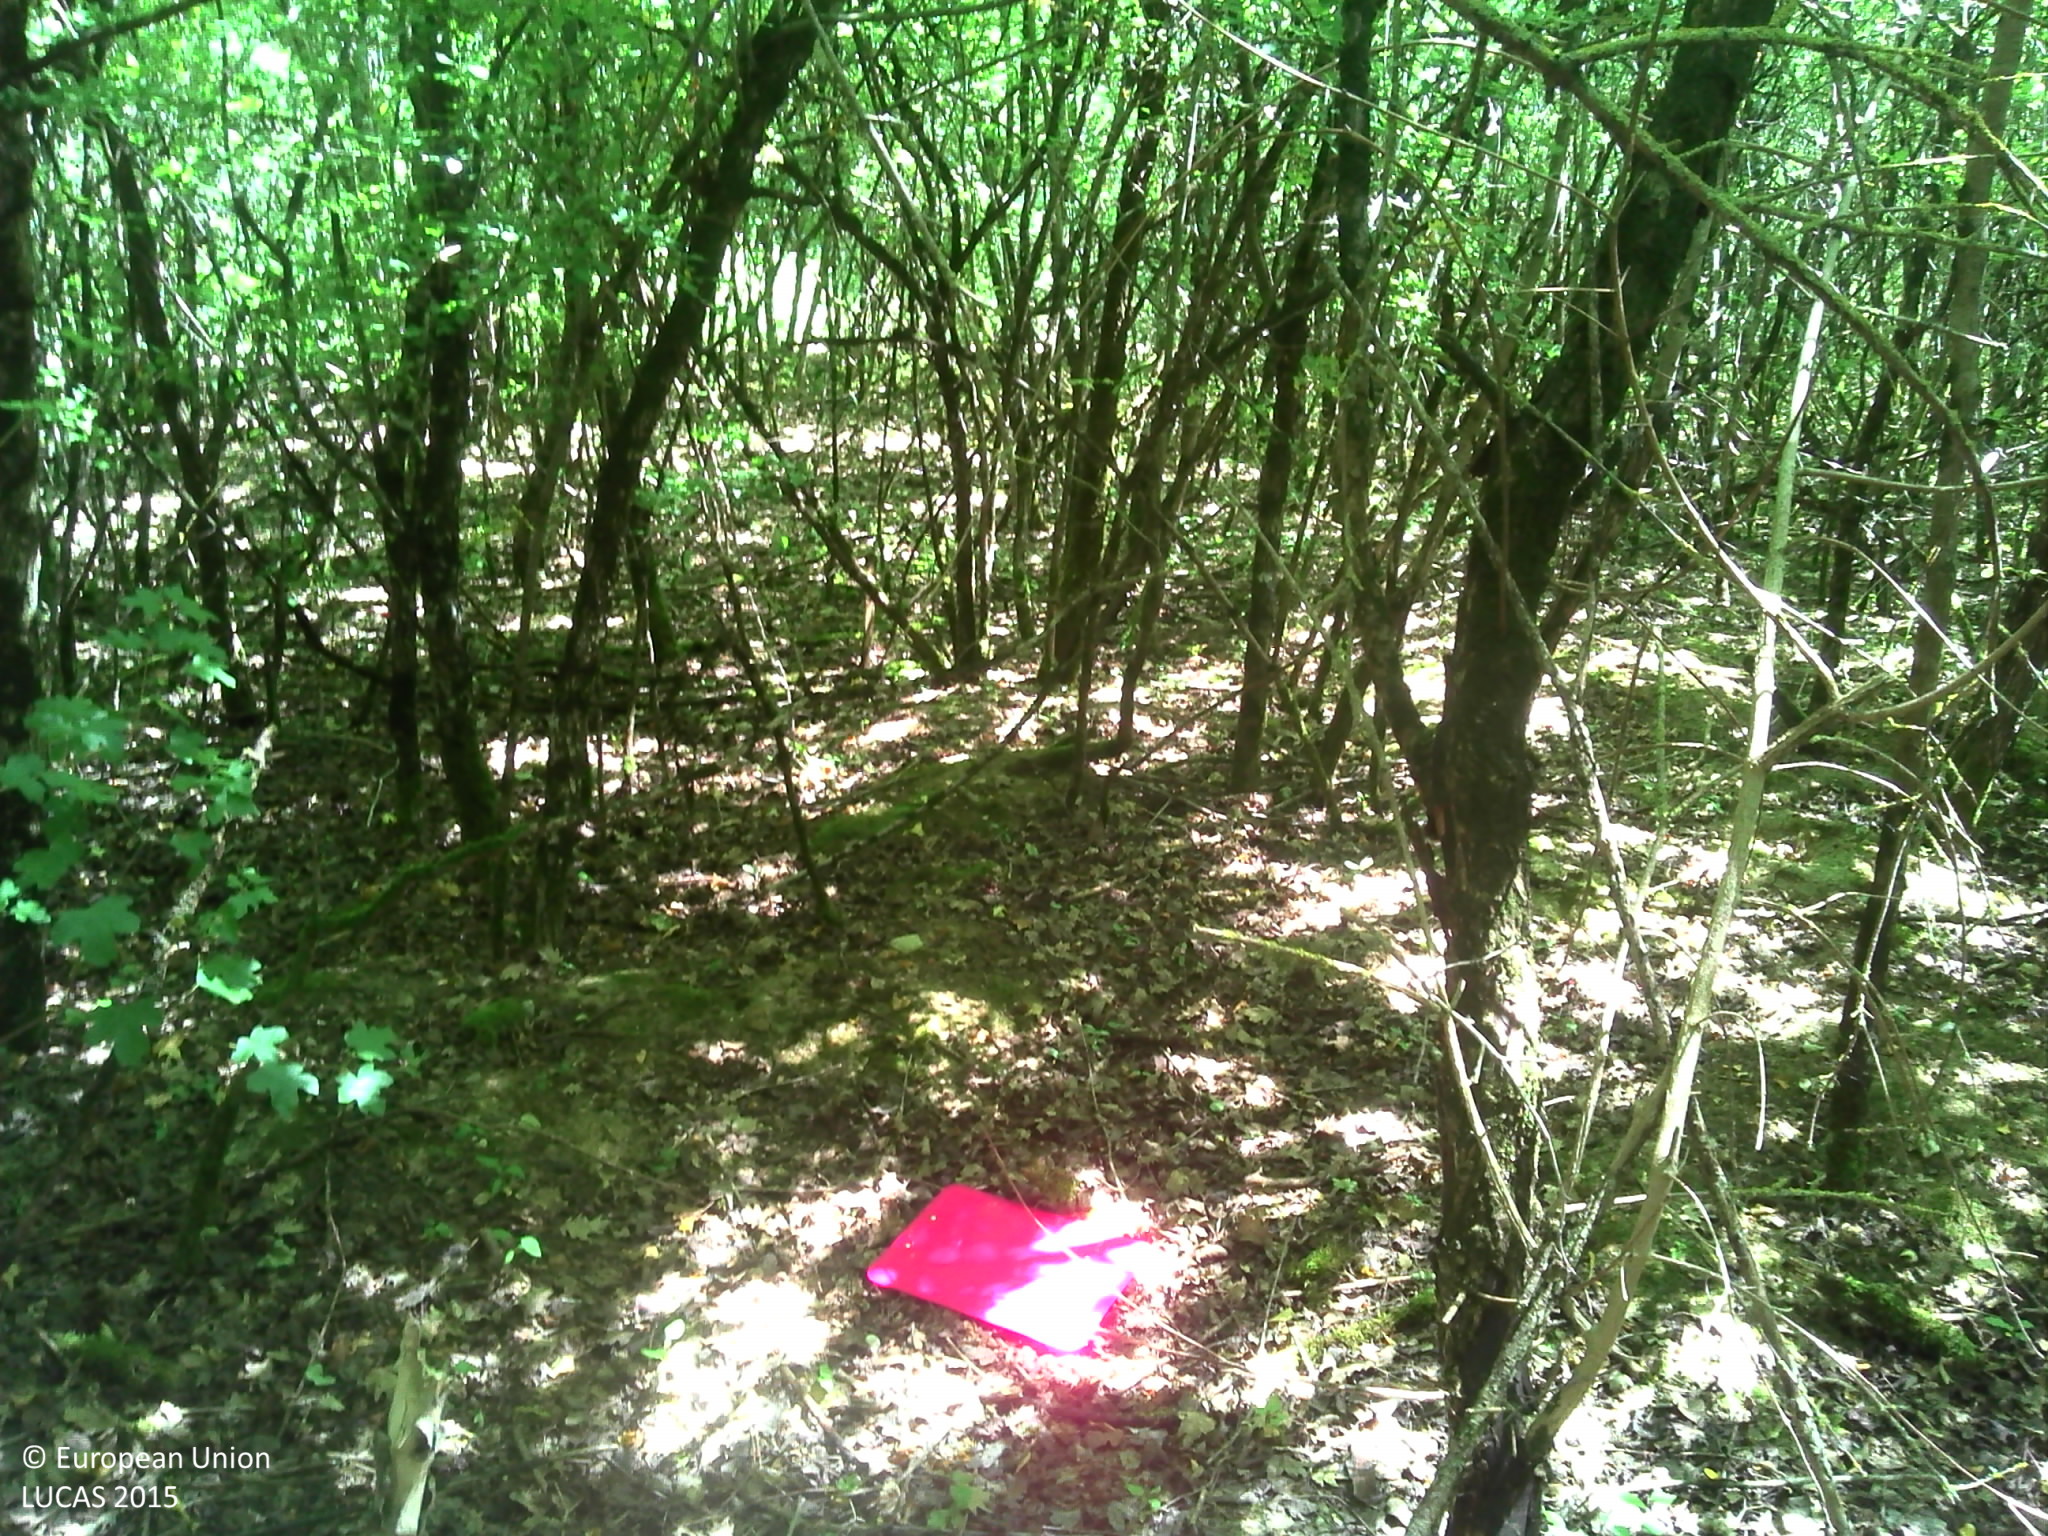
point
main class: Woodland
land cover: Broadleaved woodland
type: mesophytic deciduous forest
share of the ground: > 75 %
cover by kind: broadleaved forest trees 100 %
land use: Forestry
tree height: > 5 m
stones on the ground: < 10 %
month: June
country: FR
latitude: 43.6056
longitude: 1.9891
